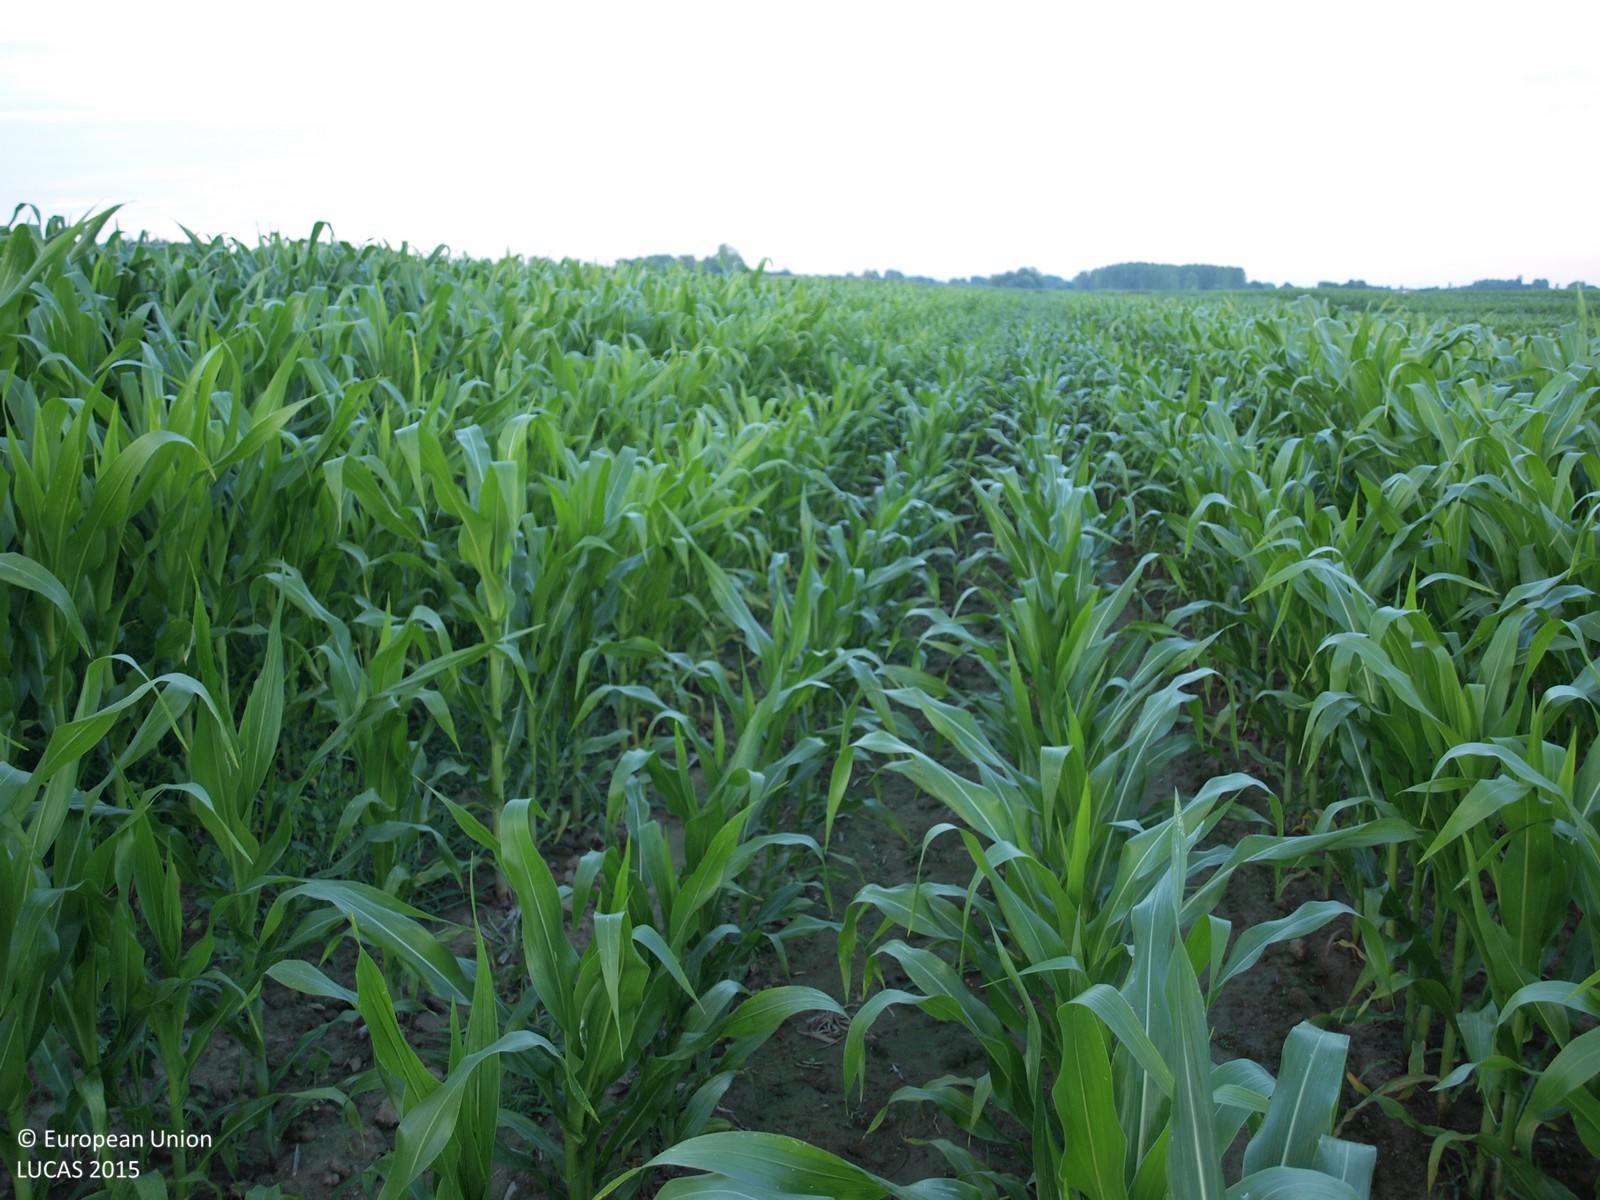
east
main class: Cropland
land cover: Maize
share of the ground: > 75 %
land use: Agriculture (excluding fallow land and kitchen gardens)
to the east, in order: Maize; Common wheat; Grass margins; Paved roads, cycling and walking lanes; Grass margins; Maize
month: June
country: HR
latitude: 46.2750
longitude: 16.5800
